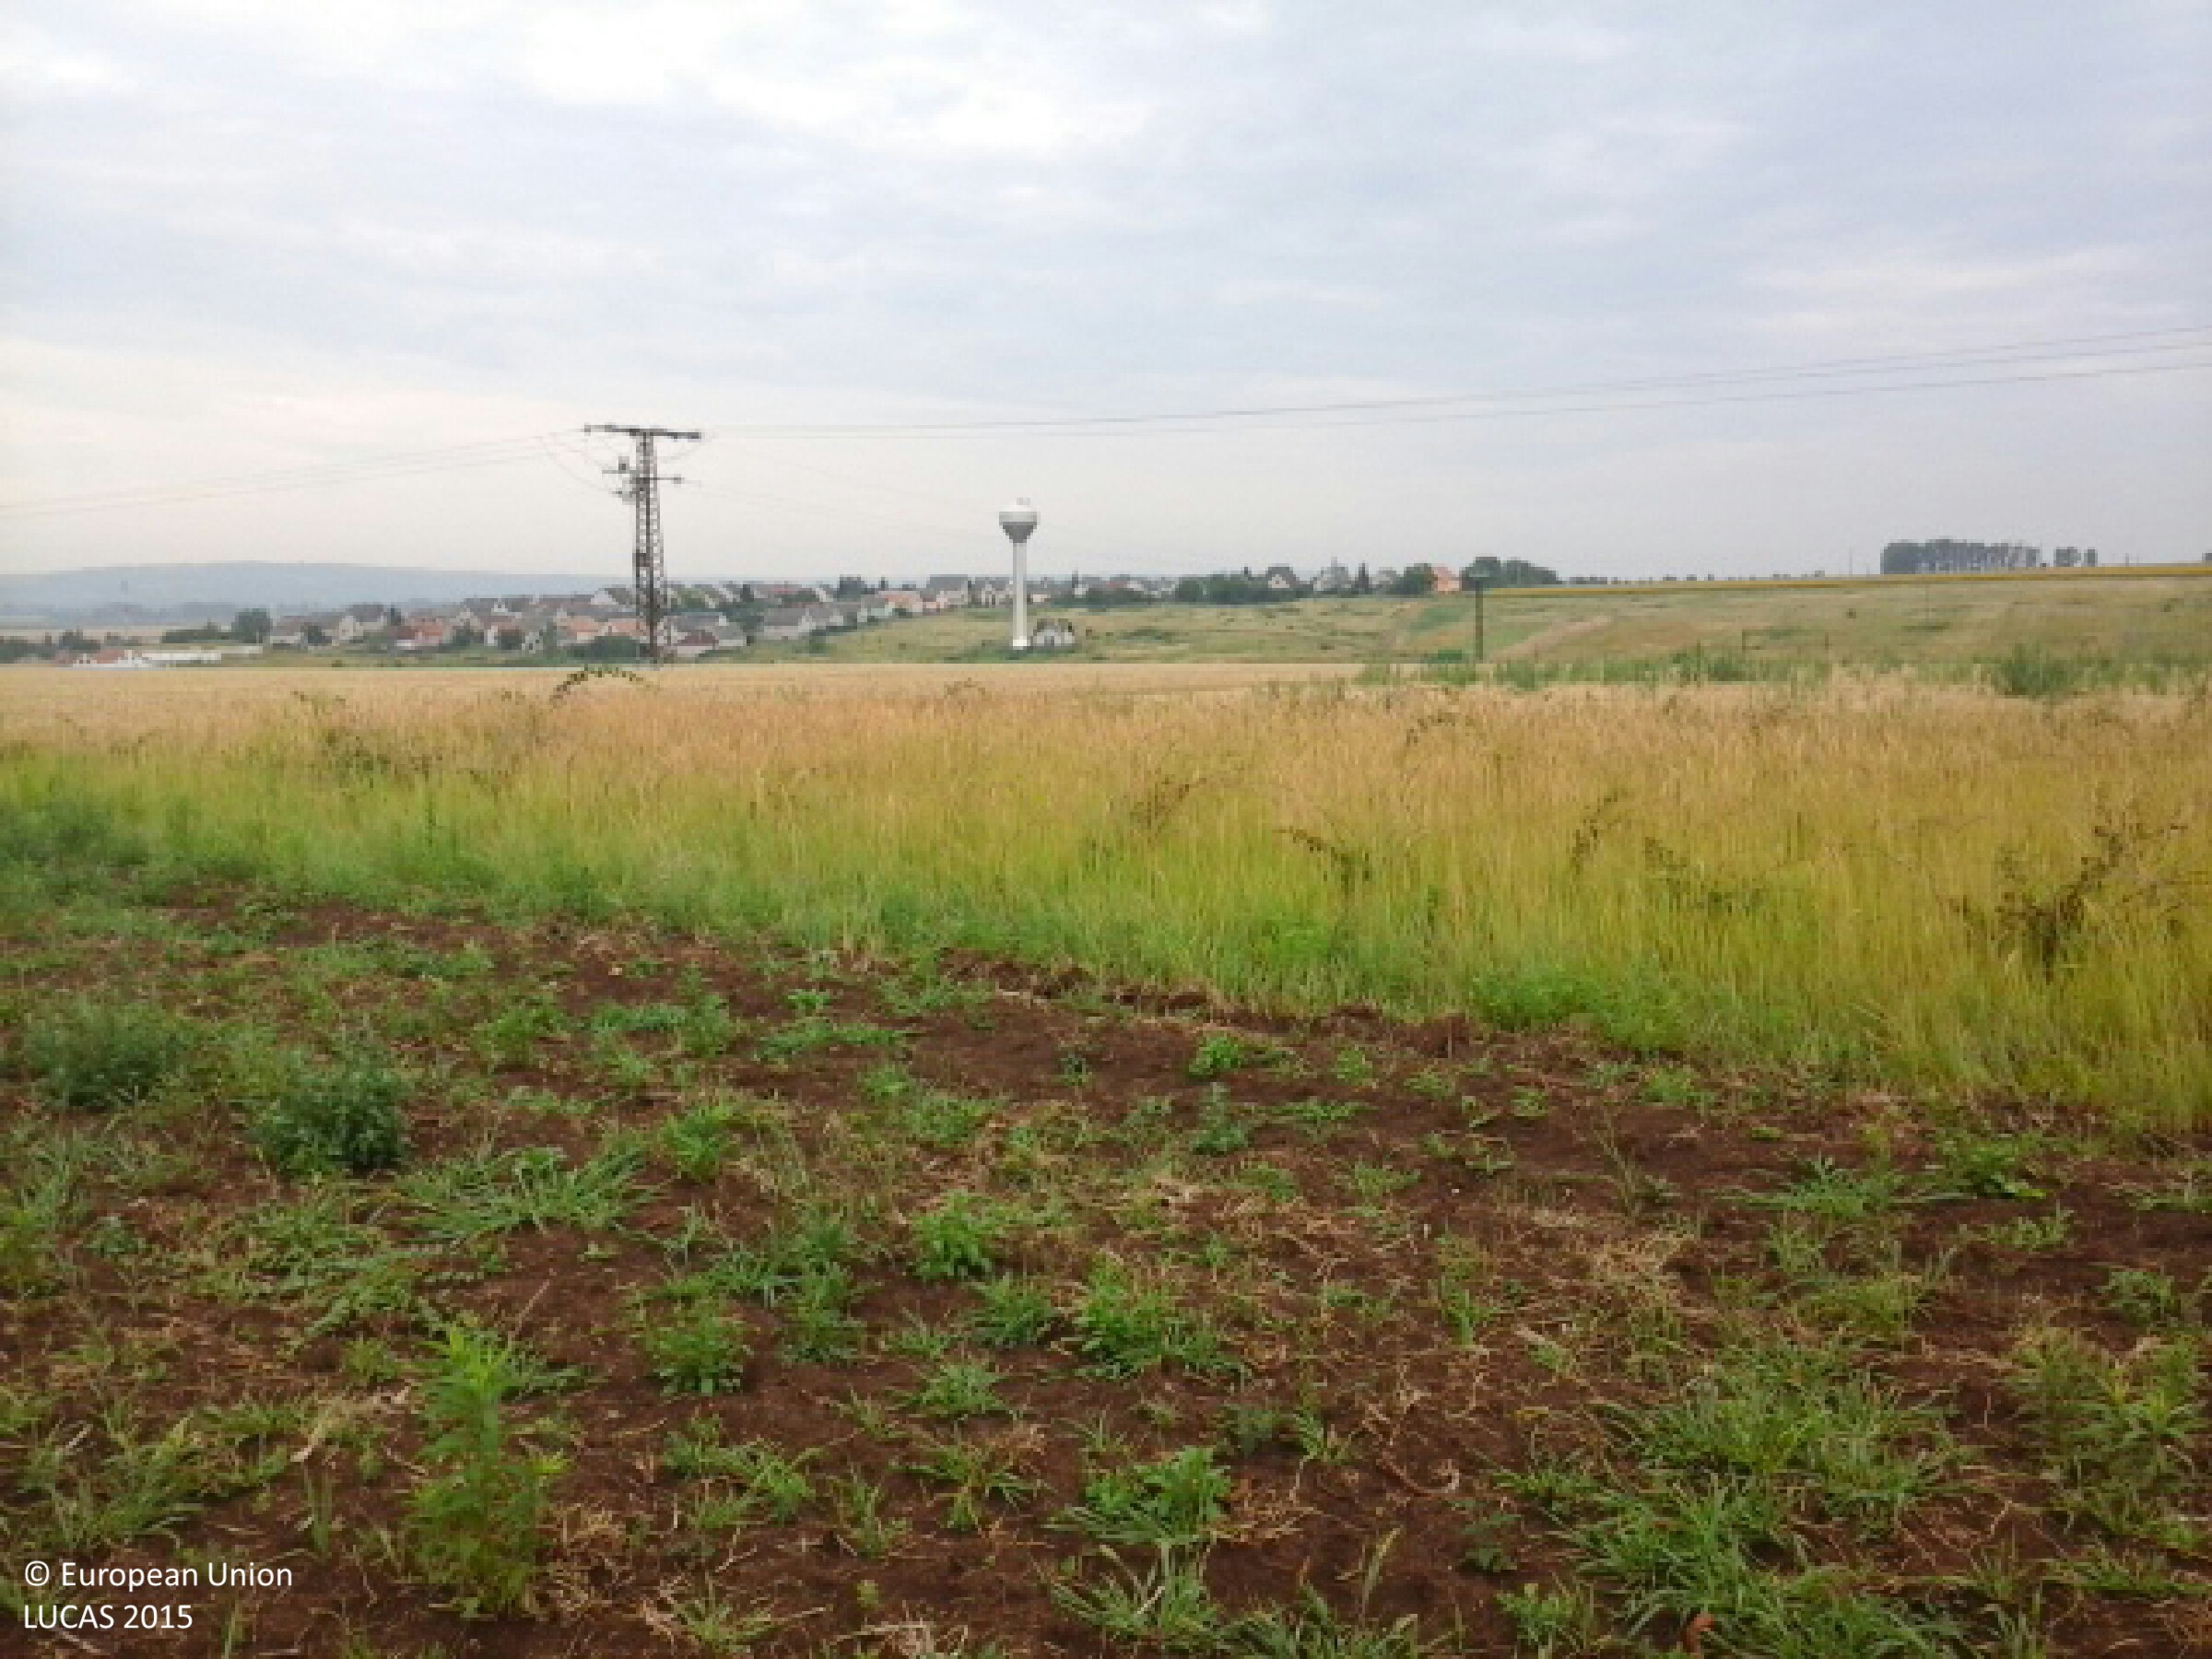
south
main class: Grassland
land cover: Spontaneously vegetated surfaces
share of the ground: 10 - 25 %
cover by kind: herbaceous plants 60 %, consolidated bare surface 40 %
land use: Fallow land
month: July
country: HU
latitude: 48.3342
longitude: 21.0893
